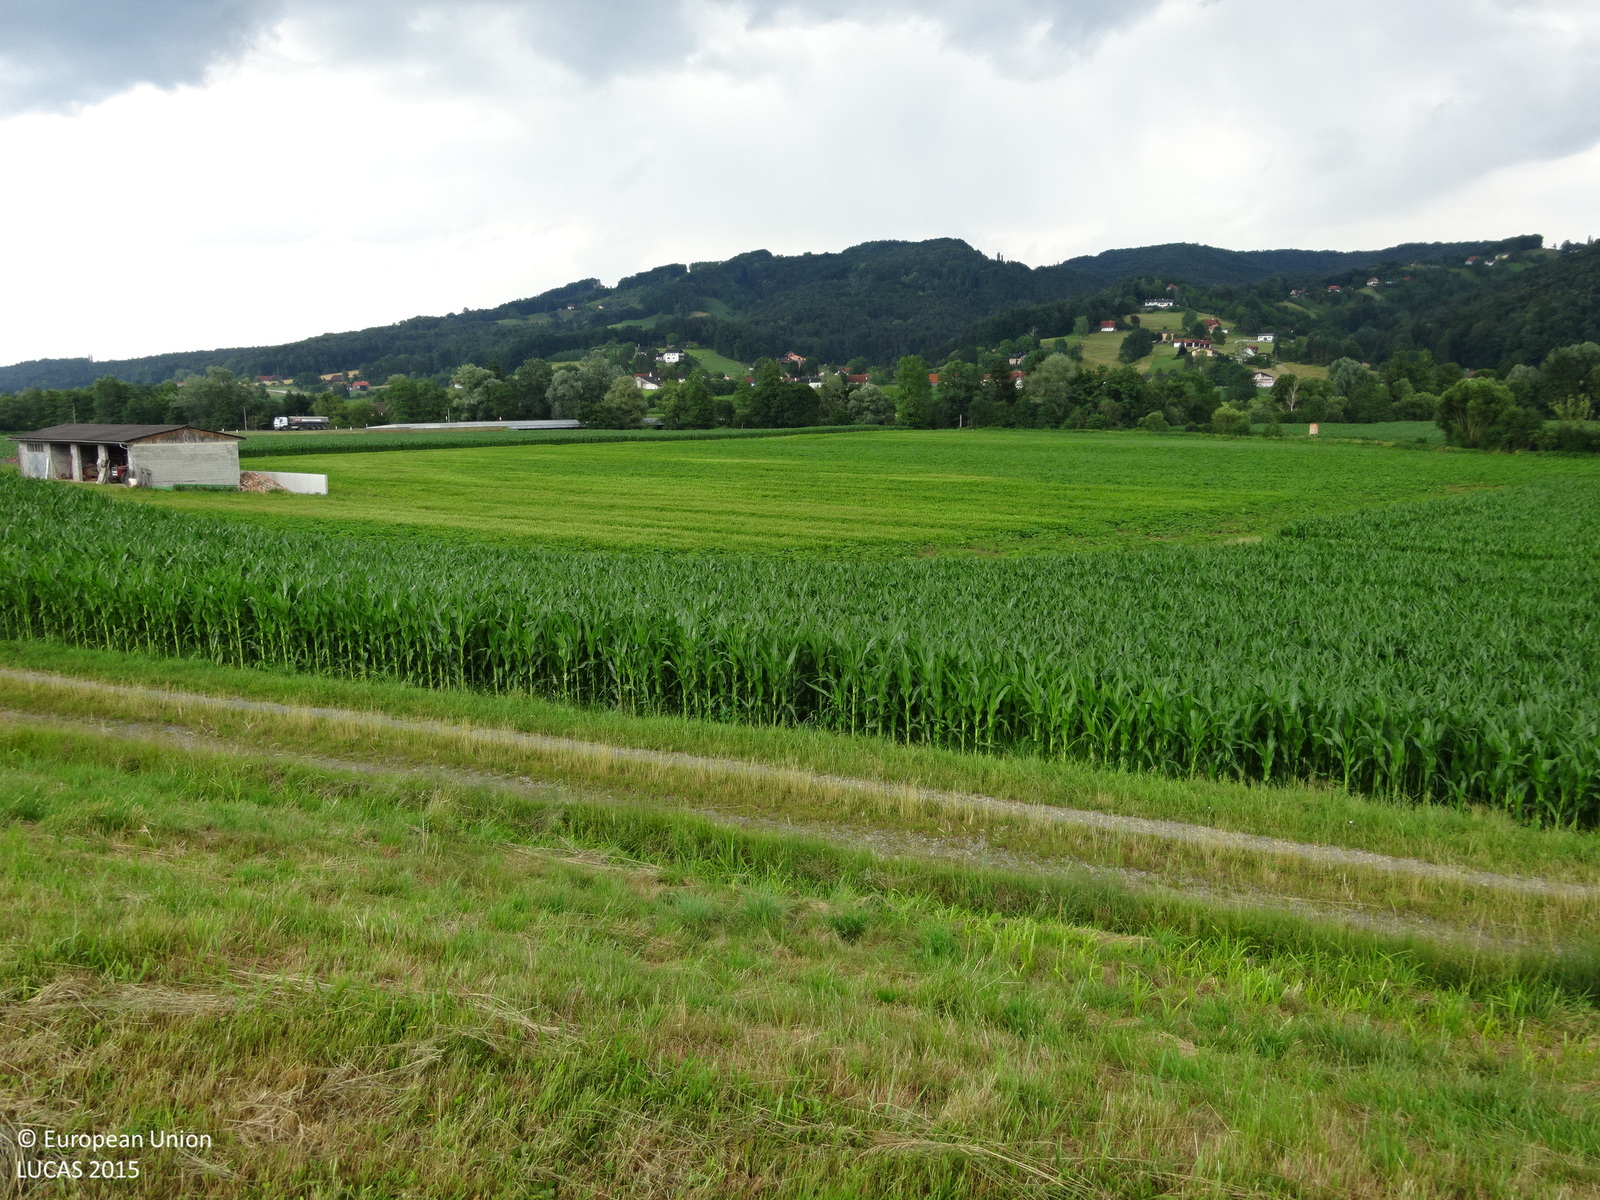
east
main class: Grassland
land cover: Grassland without tree/shrub cover
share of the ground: > 75 %
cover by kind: herbaceous plants 100 %
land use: Agriculture (excluding fallow land and kitchen gardens)
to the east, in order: Grassland without tree/shrub cover; Tracks; Grass margins; Maize; Grass margins; Other fibre and oleaginous crops; Ditches and canals; Grass margins; Paved roads, cycling and walking lanes; Grass margins; Maize
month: June
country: AT
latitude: 46.7201
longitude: 15.4023
